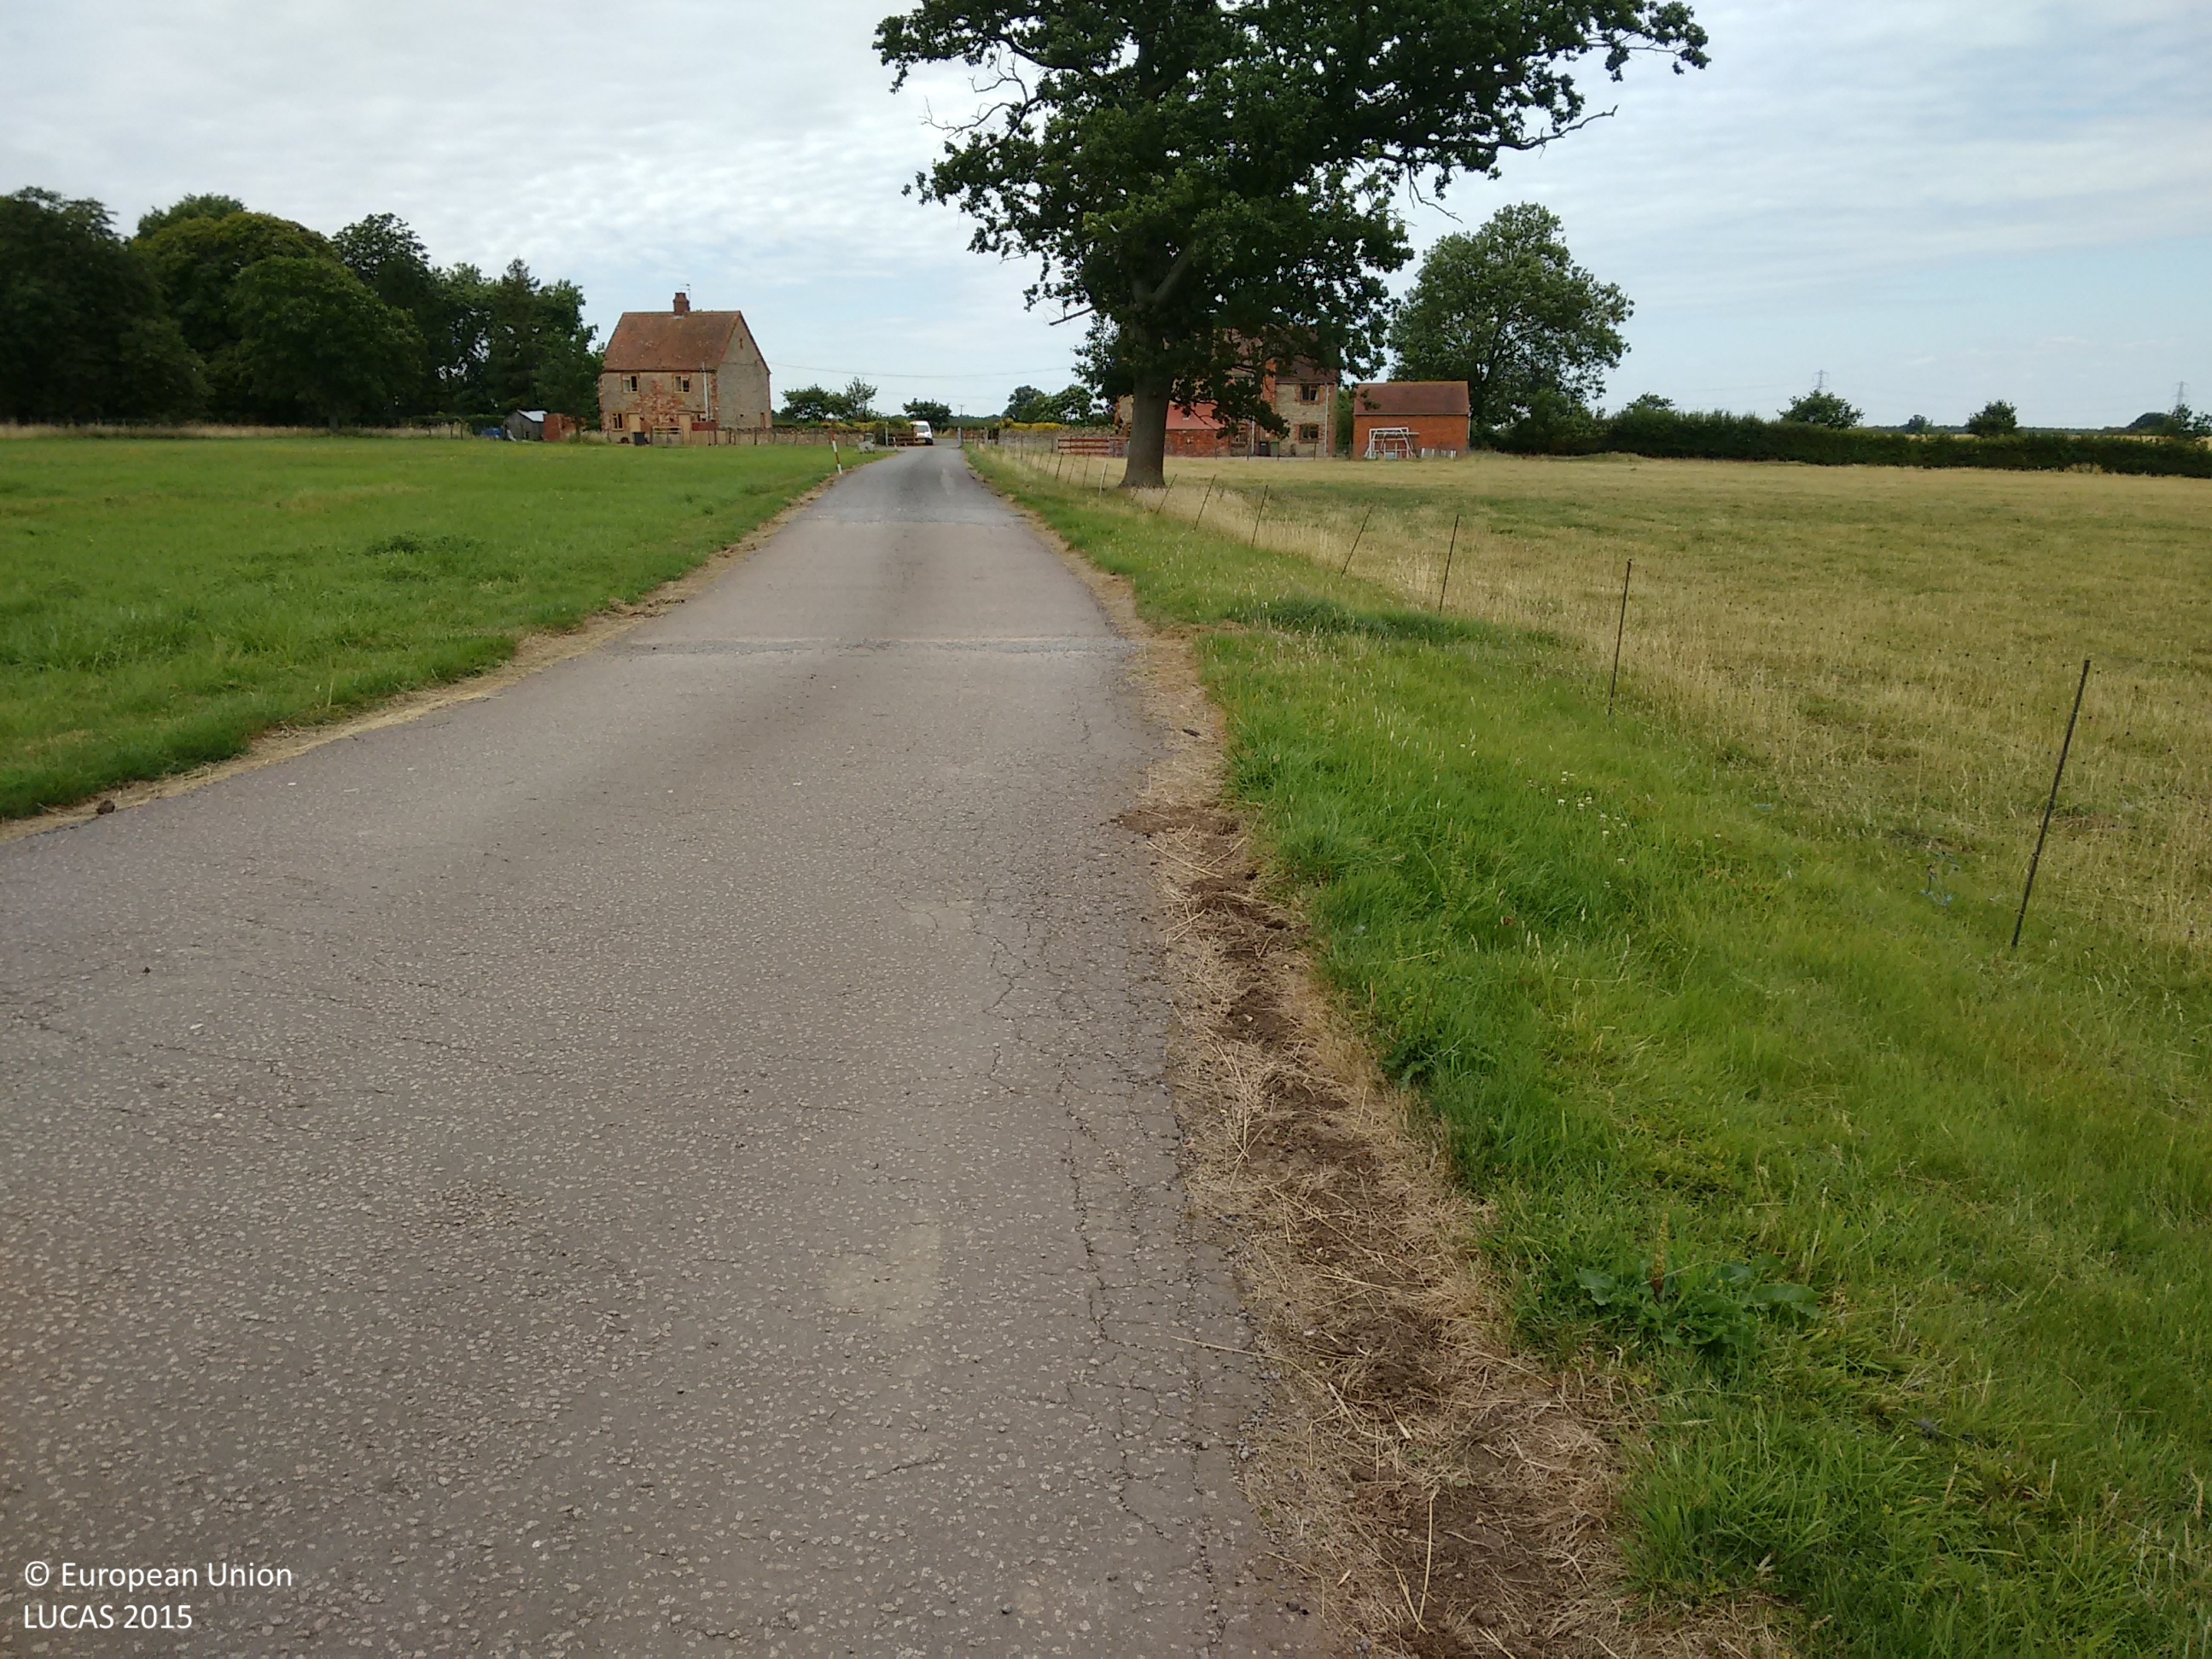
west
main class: Grassland
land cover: Grassland without tree/shrub cover
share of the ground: > 75 %
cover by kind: herbaceous plants 100 %
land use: Agriculture (excluding fallow land and kitchen gardens)
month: August
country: GB
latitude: 52.2028
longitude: -0.6779
